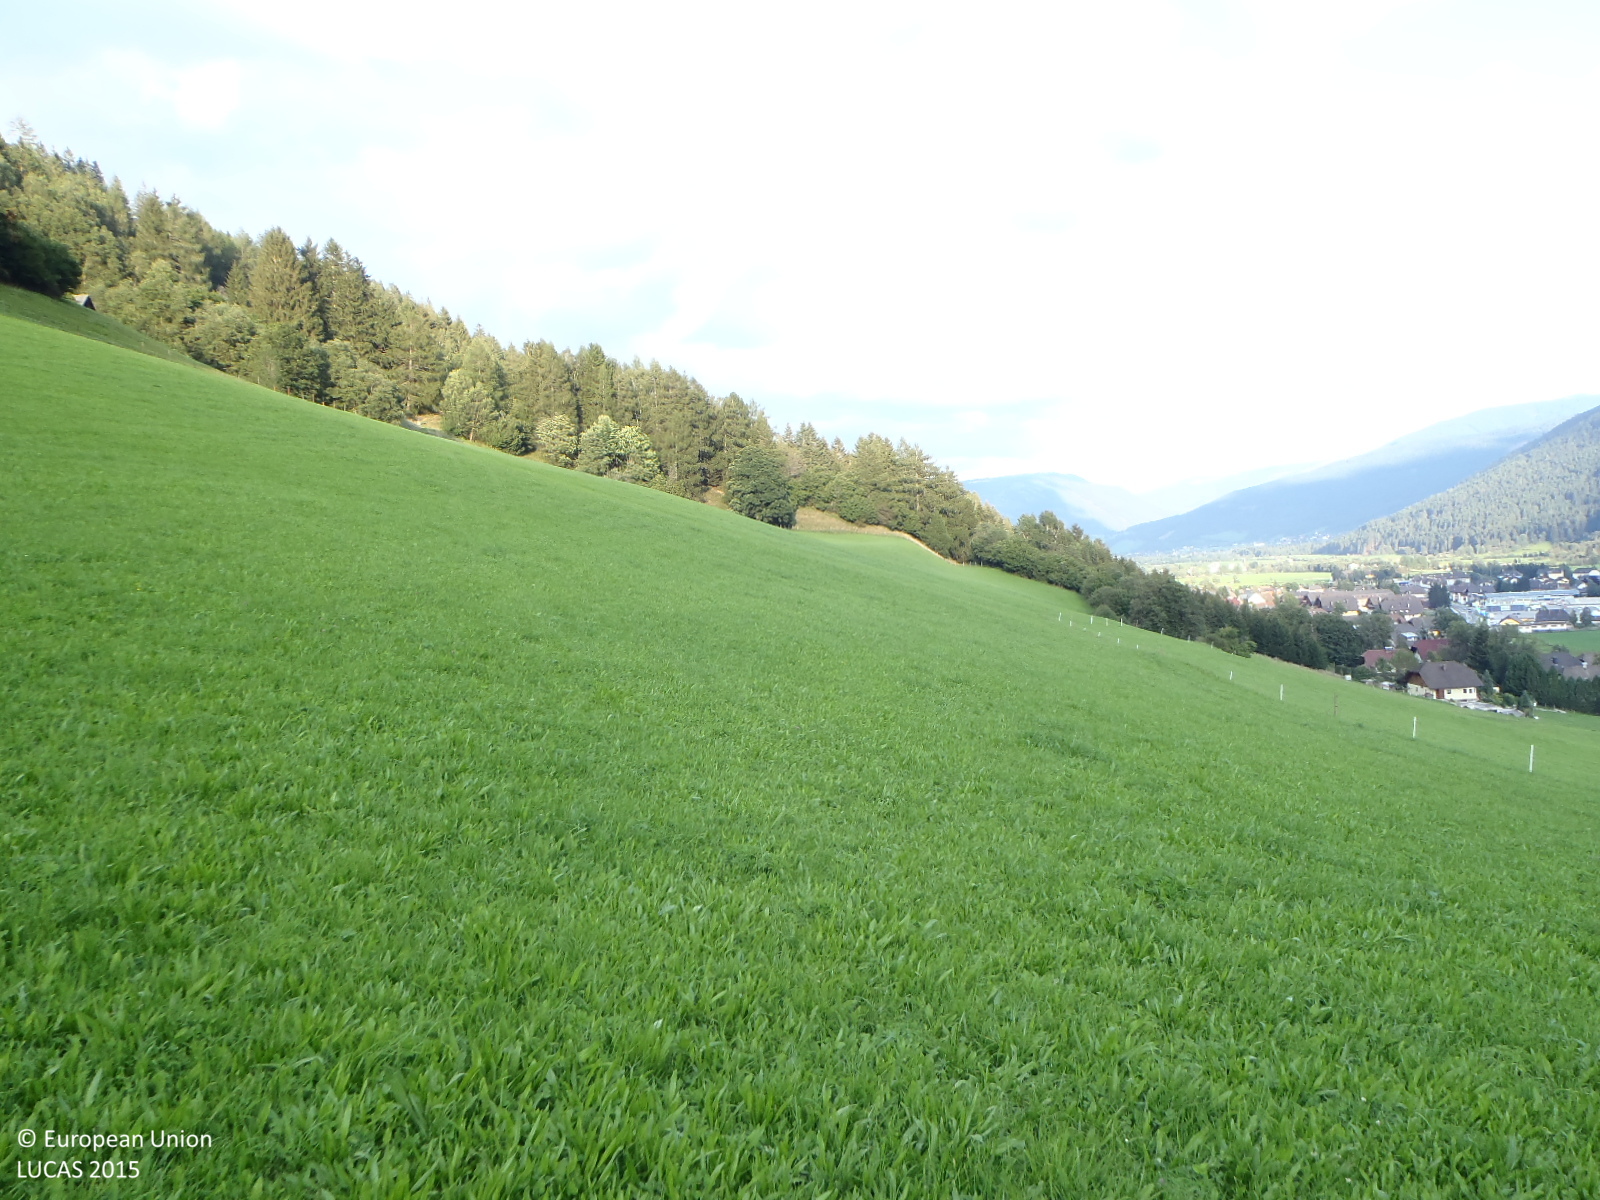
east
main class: Grassland
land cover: Grassland without tree/shrub cover
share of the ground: > 75 %
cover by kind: herbaceous plants 100 %
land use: Agriculture (excluding fallow land and kitchen gardens)
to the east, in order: Grassland without tree/shrub cover; Ditches and canals; Grassland without tree/shrub cover
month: August
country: AT
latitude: 47.1011
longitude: 13.6213
